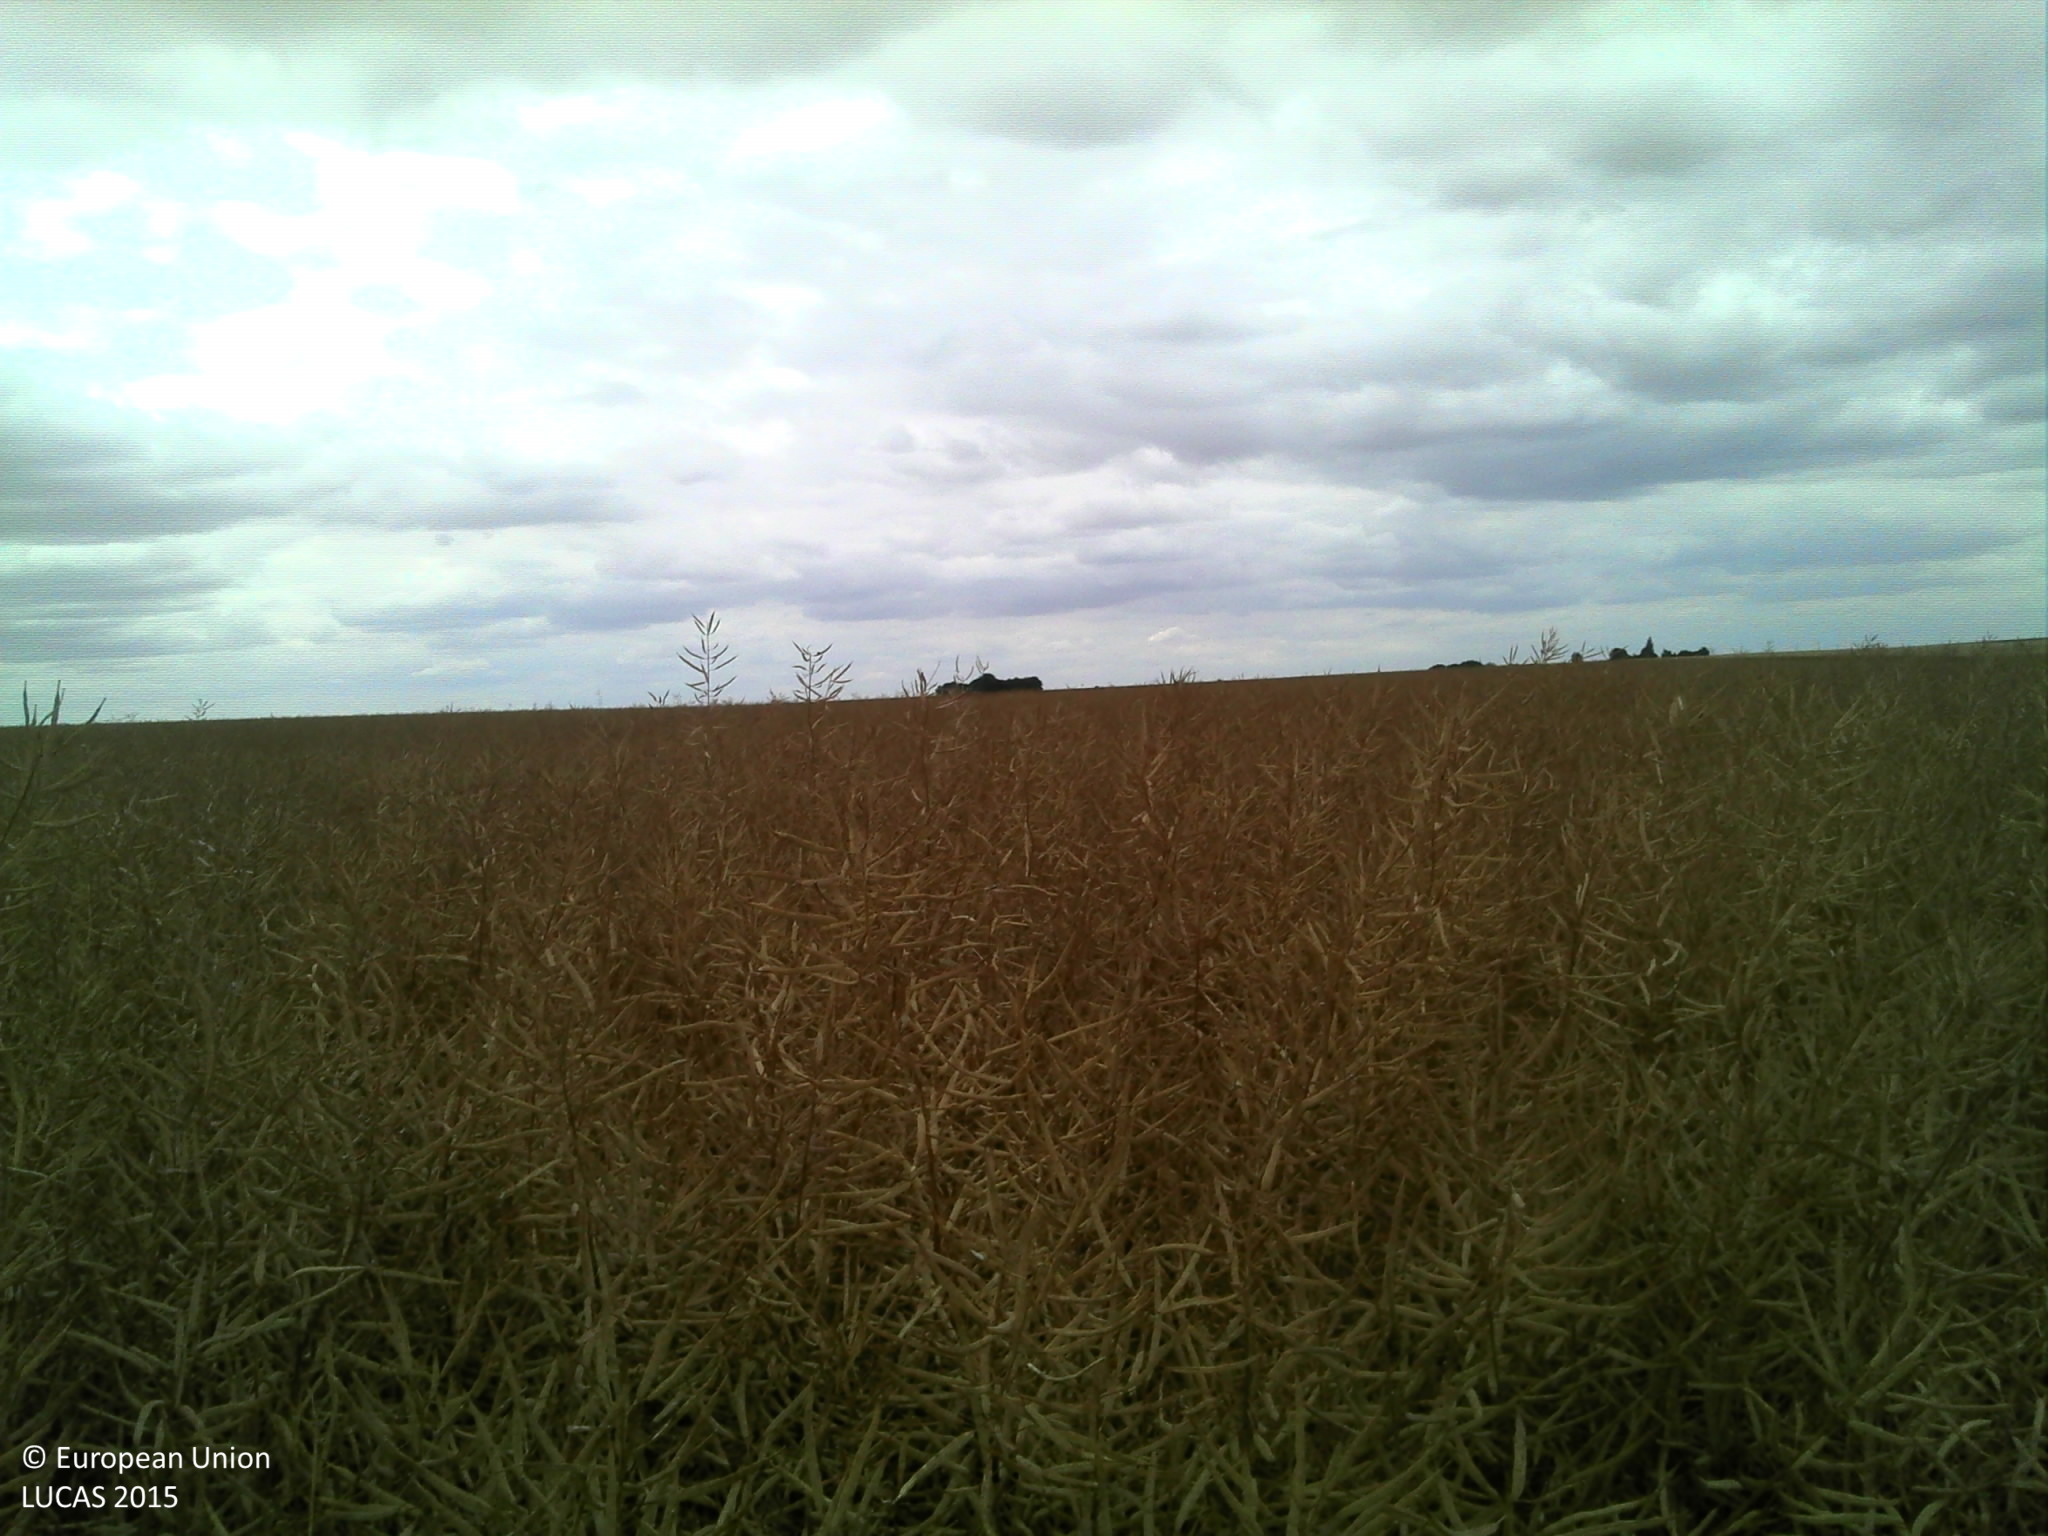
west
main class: Cropland
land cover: Rape and turnip rape
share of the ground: > 75 %
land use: Agriculture (excluding fallow land and kitchen gardens)
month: July
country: FR
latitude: 48.3504
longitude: 3.3952
